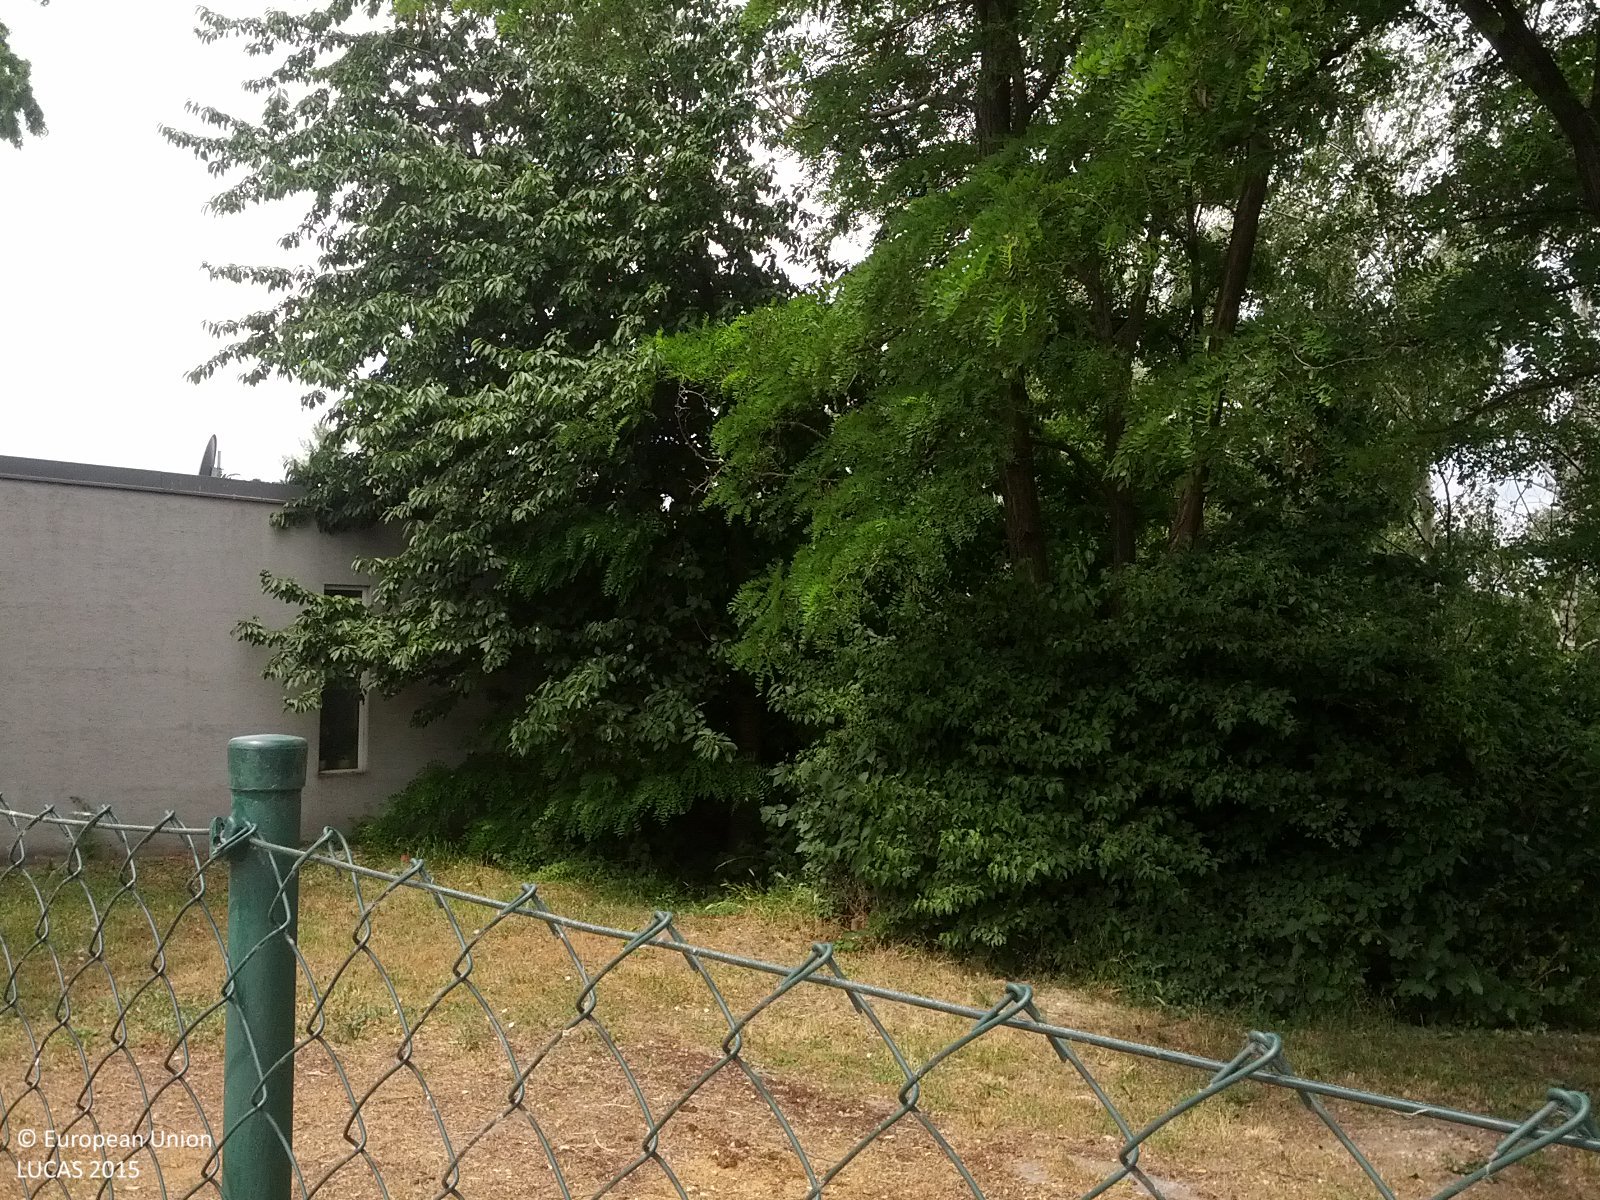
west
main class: Woodland
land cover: Broadleaved woodland
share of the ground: 25 - 50 %
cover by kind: herbaceous plants 60 %, broadleaved forest trees 35 %, shrubs 5 %
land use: Amenities, museums, leisure
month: June
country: AT
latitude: 48.1908
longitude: 16.5569
